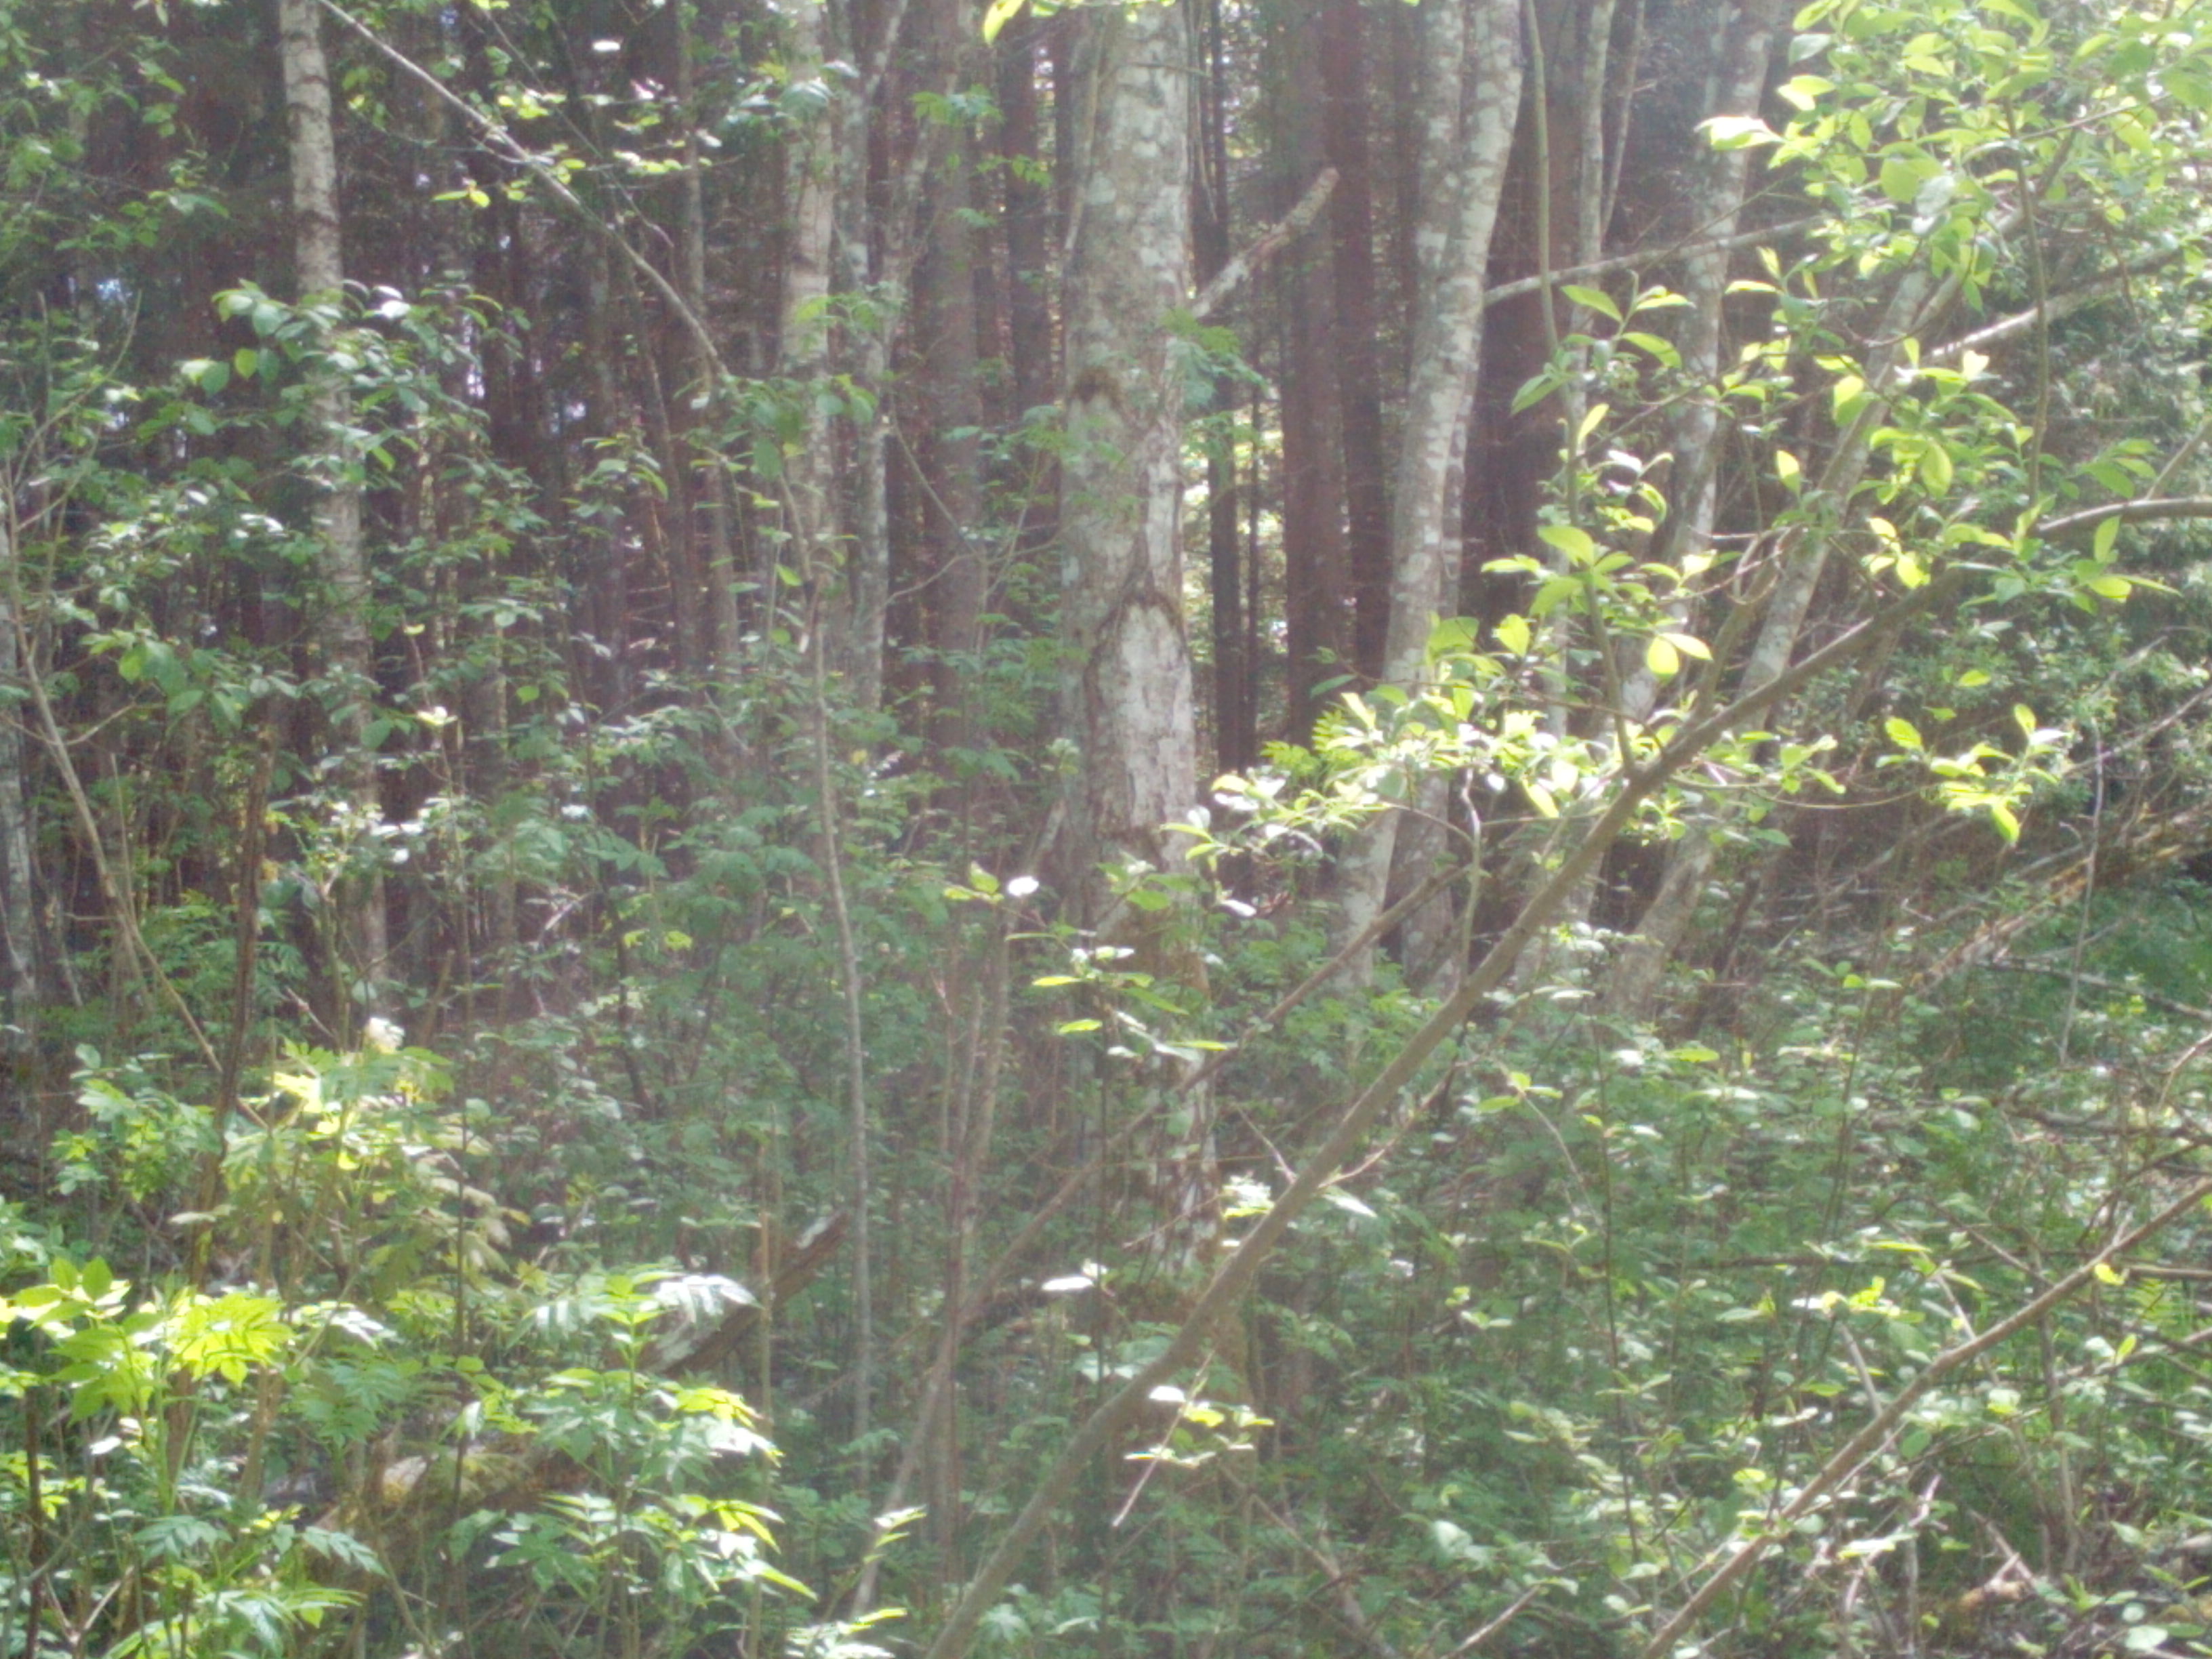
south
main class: Woodland
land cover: Spruce dominated mixed woodland
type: hemiboreal forest and nemoral coniferous forest and mixed broadleaved-coniferous forest
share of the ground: > 75 %
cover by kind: broadleaved forest trees 60 %, coniferous forest trees 40 %
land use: Forestry
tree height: > 5 m
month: May
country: LV
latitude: 56.4843
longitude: 22.3145
